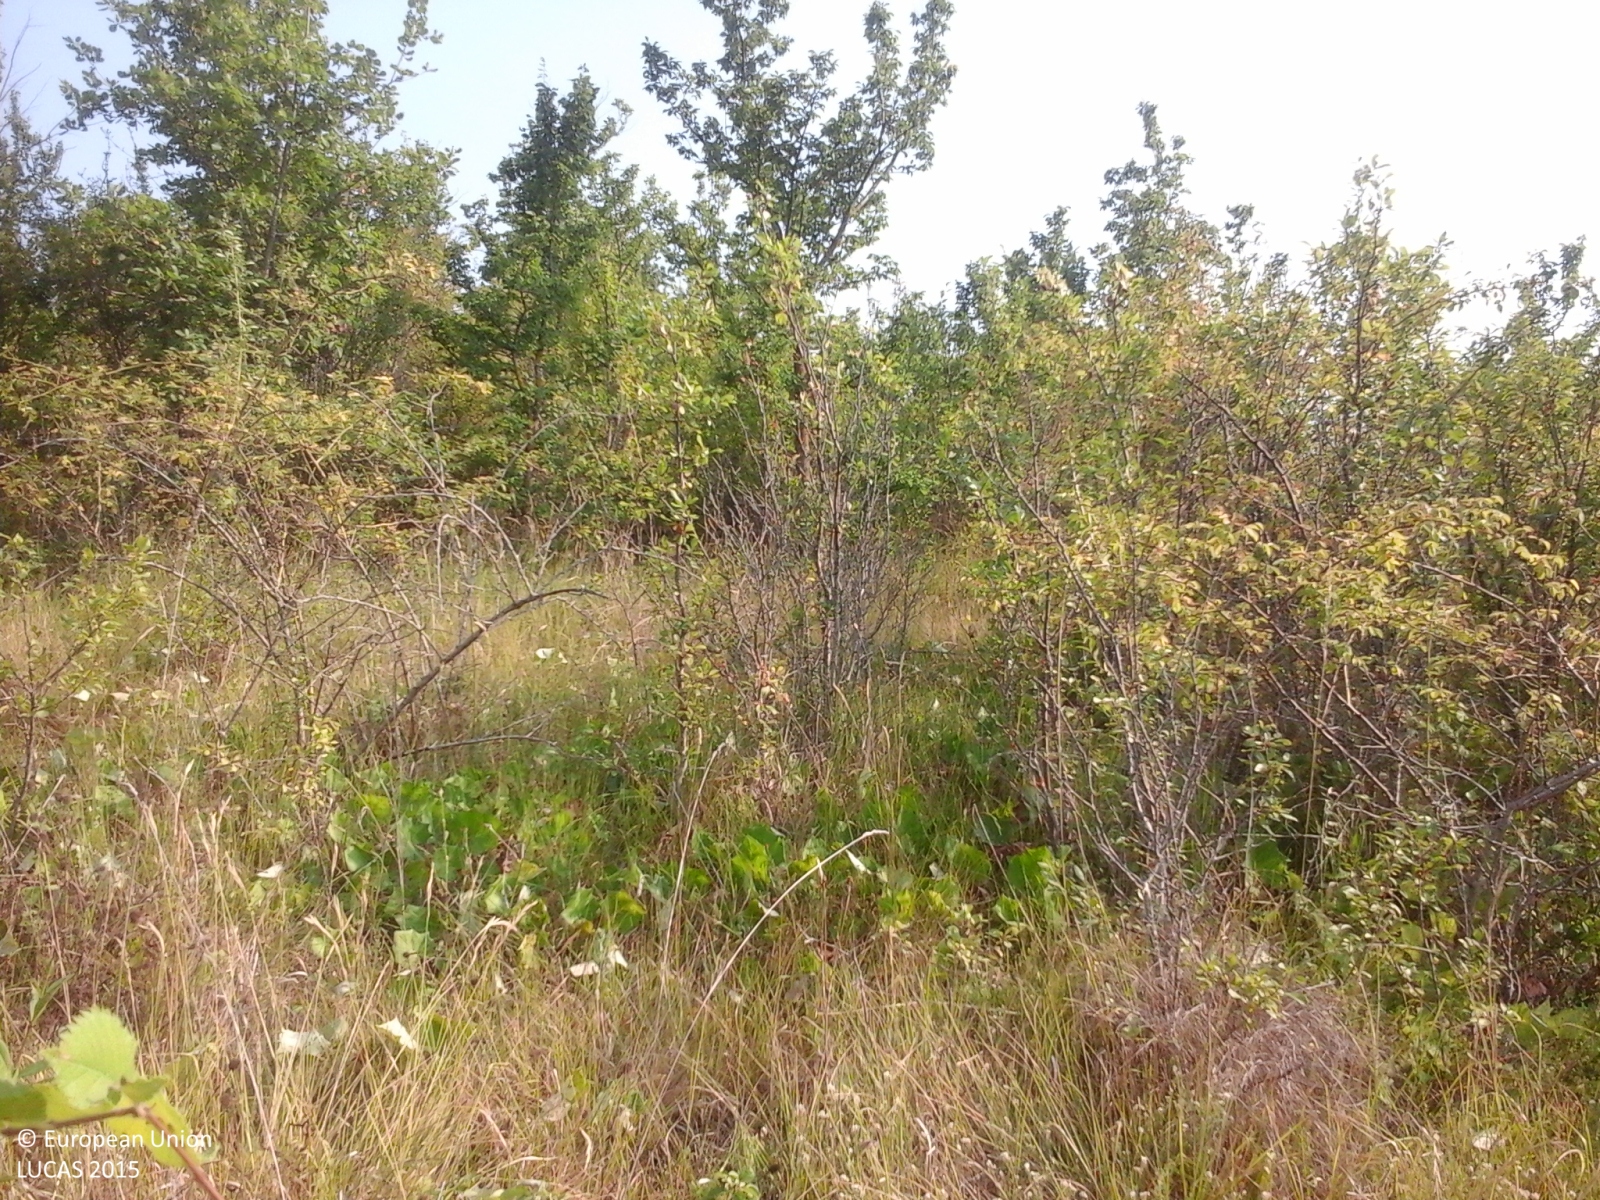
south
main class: Woodland
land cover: Broadleaved woodland
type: thermophilous deciduous forest
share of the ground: > 75 %
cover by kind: broadleaved forest trees 70 %, shrubs 25 %, herbaceous plants 5 %
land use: Forestry
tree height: > 5 m
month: July
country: IT
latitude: 40.8974
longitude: 15.0725
